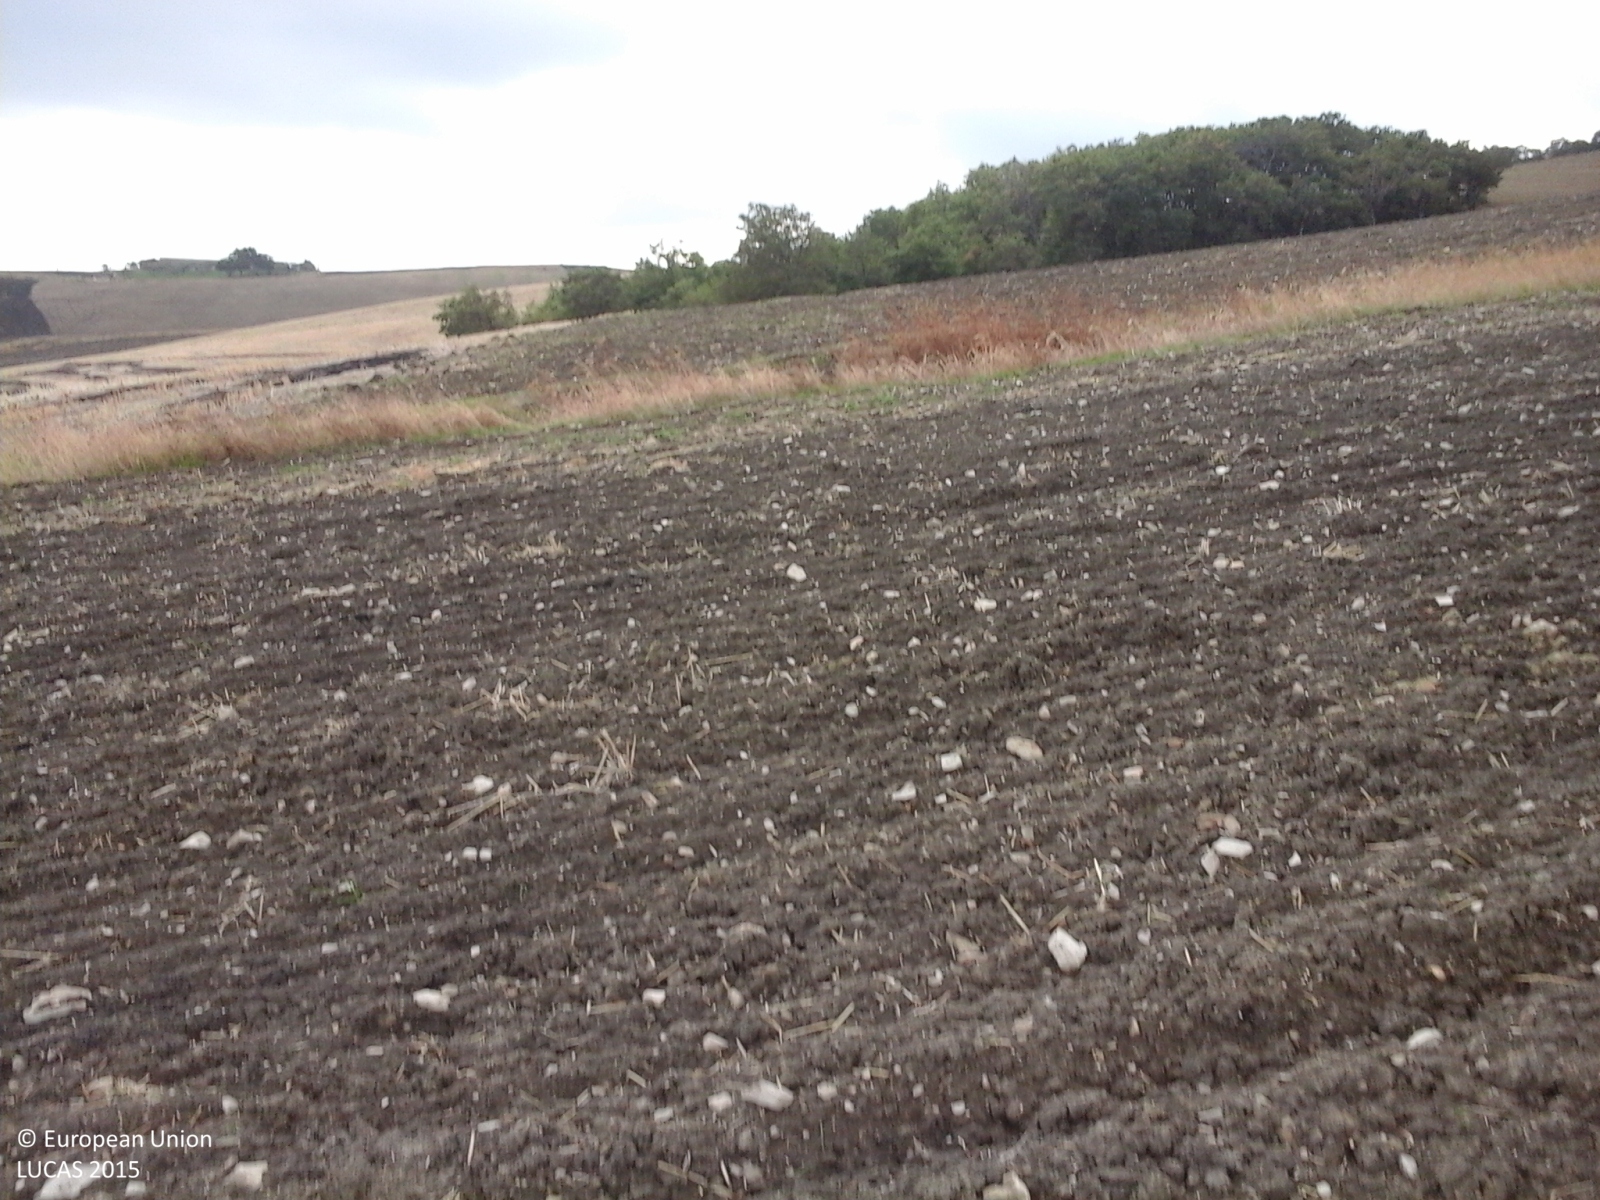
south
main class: Cropland
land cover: Durum wheat
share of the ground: > 75 %
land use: Agriculture (excluding fallow land and kitchen gardens)
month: October
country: IT
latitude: 41.4734
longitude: 15.1436
